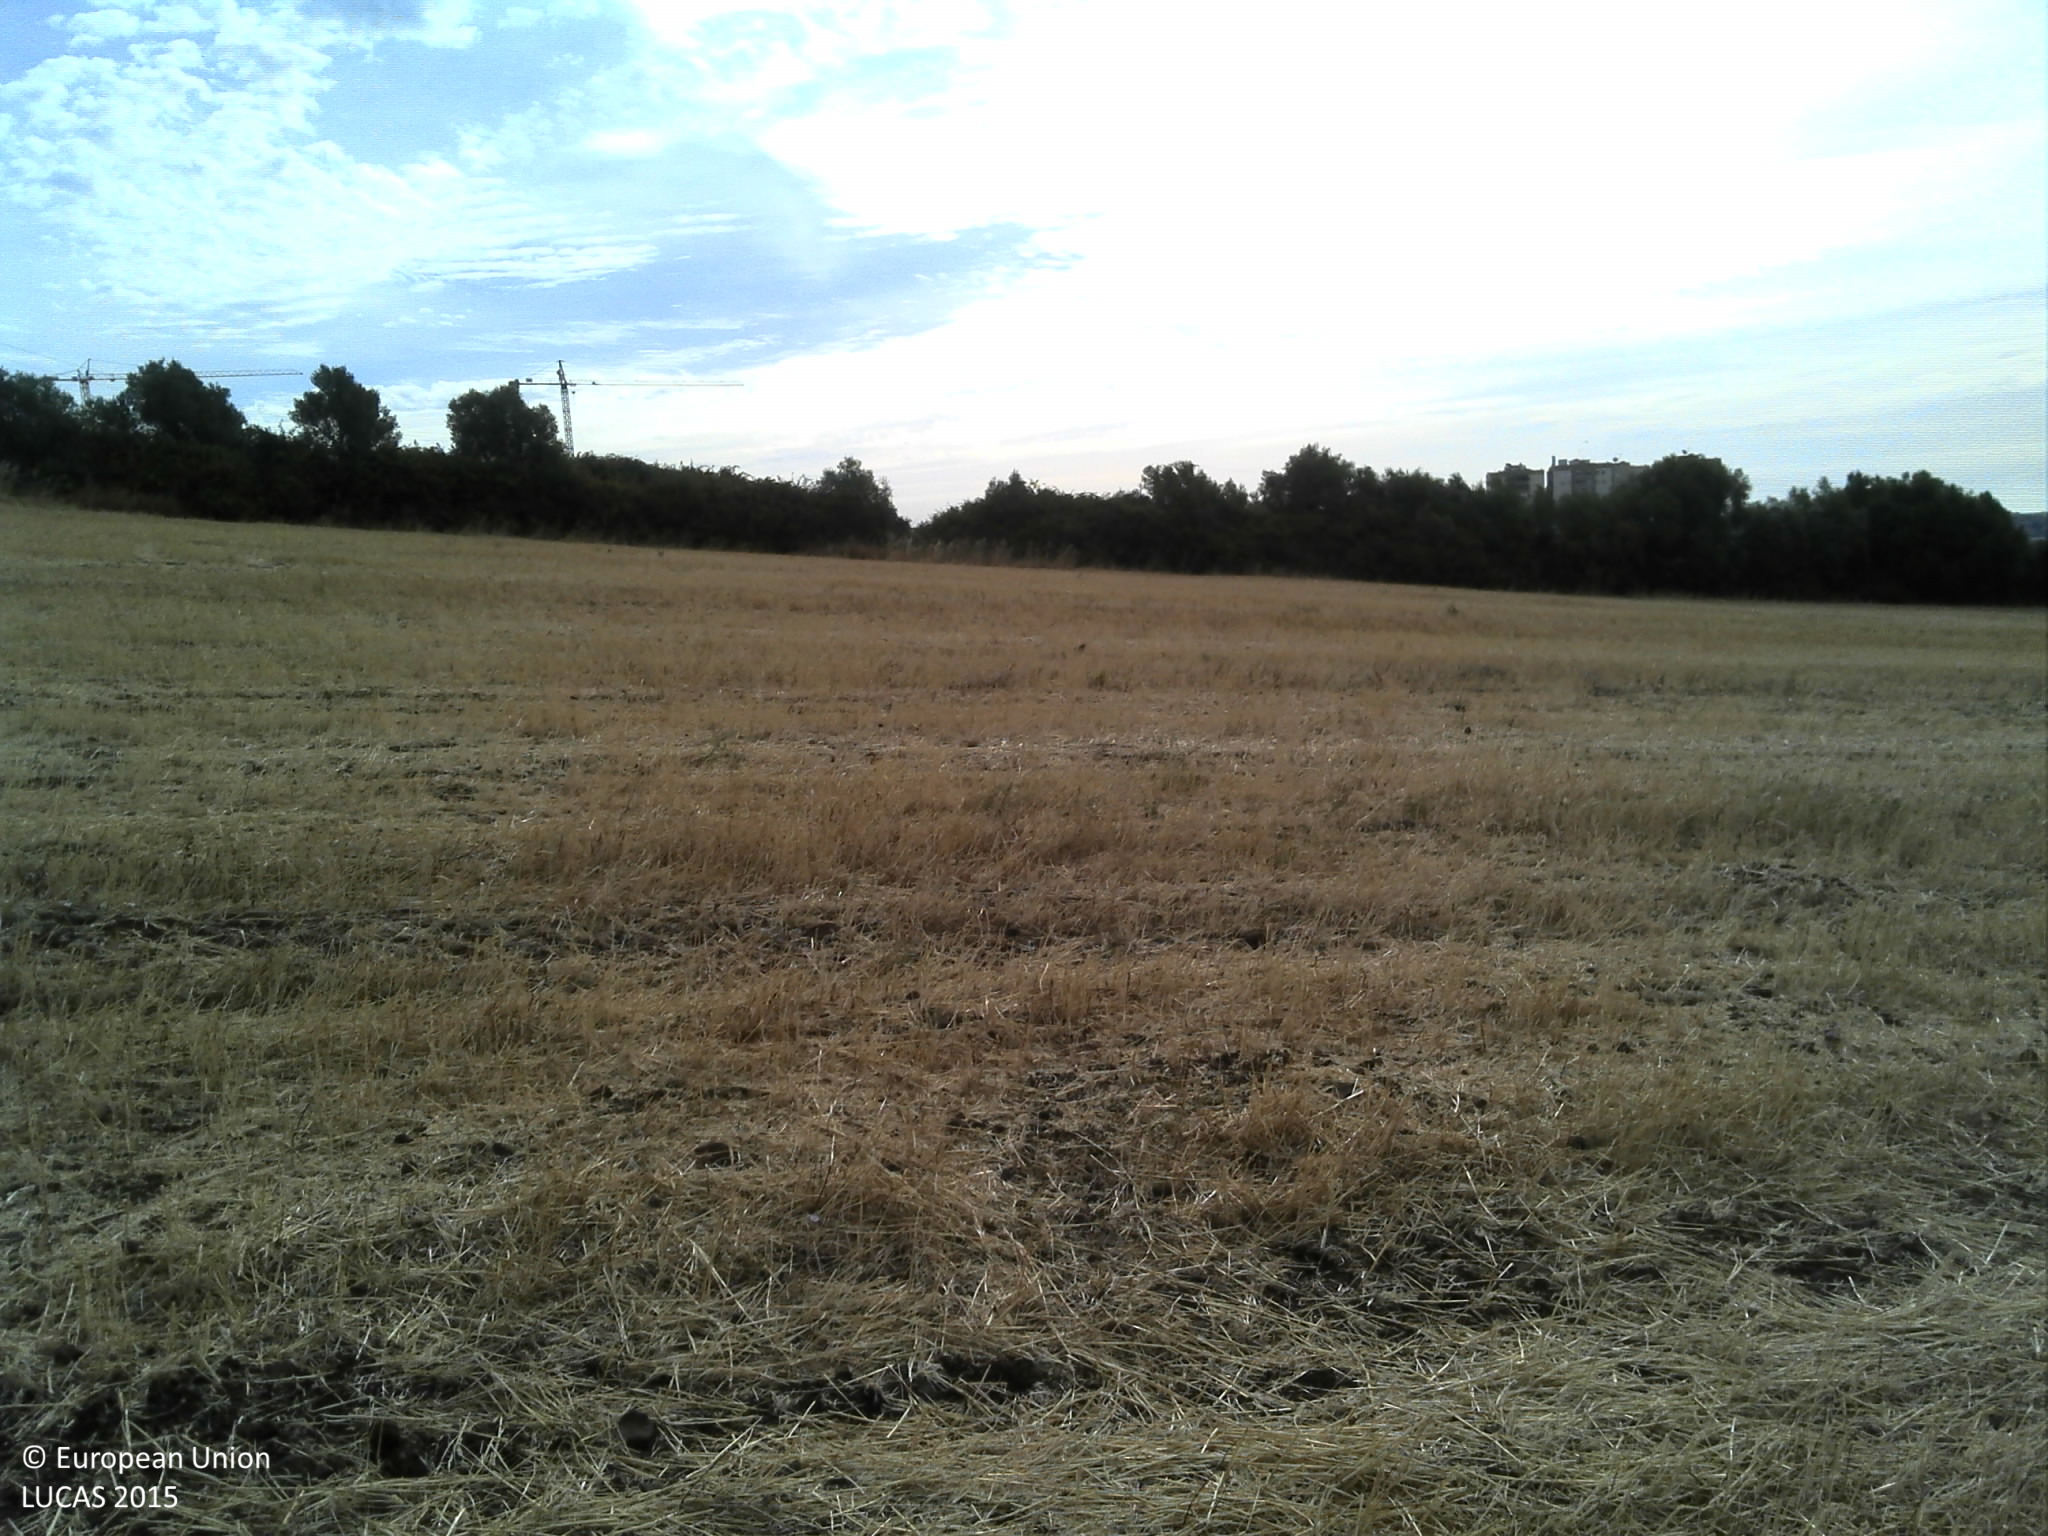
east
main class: Grassland
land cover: Grassland without tree/shrub cover
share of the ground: 25 - 50 %
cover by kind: herbaceous plants 50 %, unconsolidated bare surface 50 %
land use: Agriculture (excluding fallow land and kitchen gardens)
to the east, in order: Grassland without tree/shrub cover; Shruby margins; Abandoned hedges; Grassland without tree/shrub cover
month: August
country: PT
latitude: 38.7951
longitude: -9.2025
